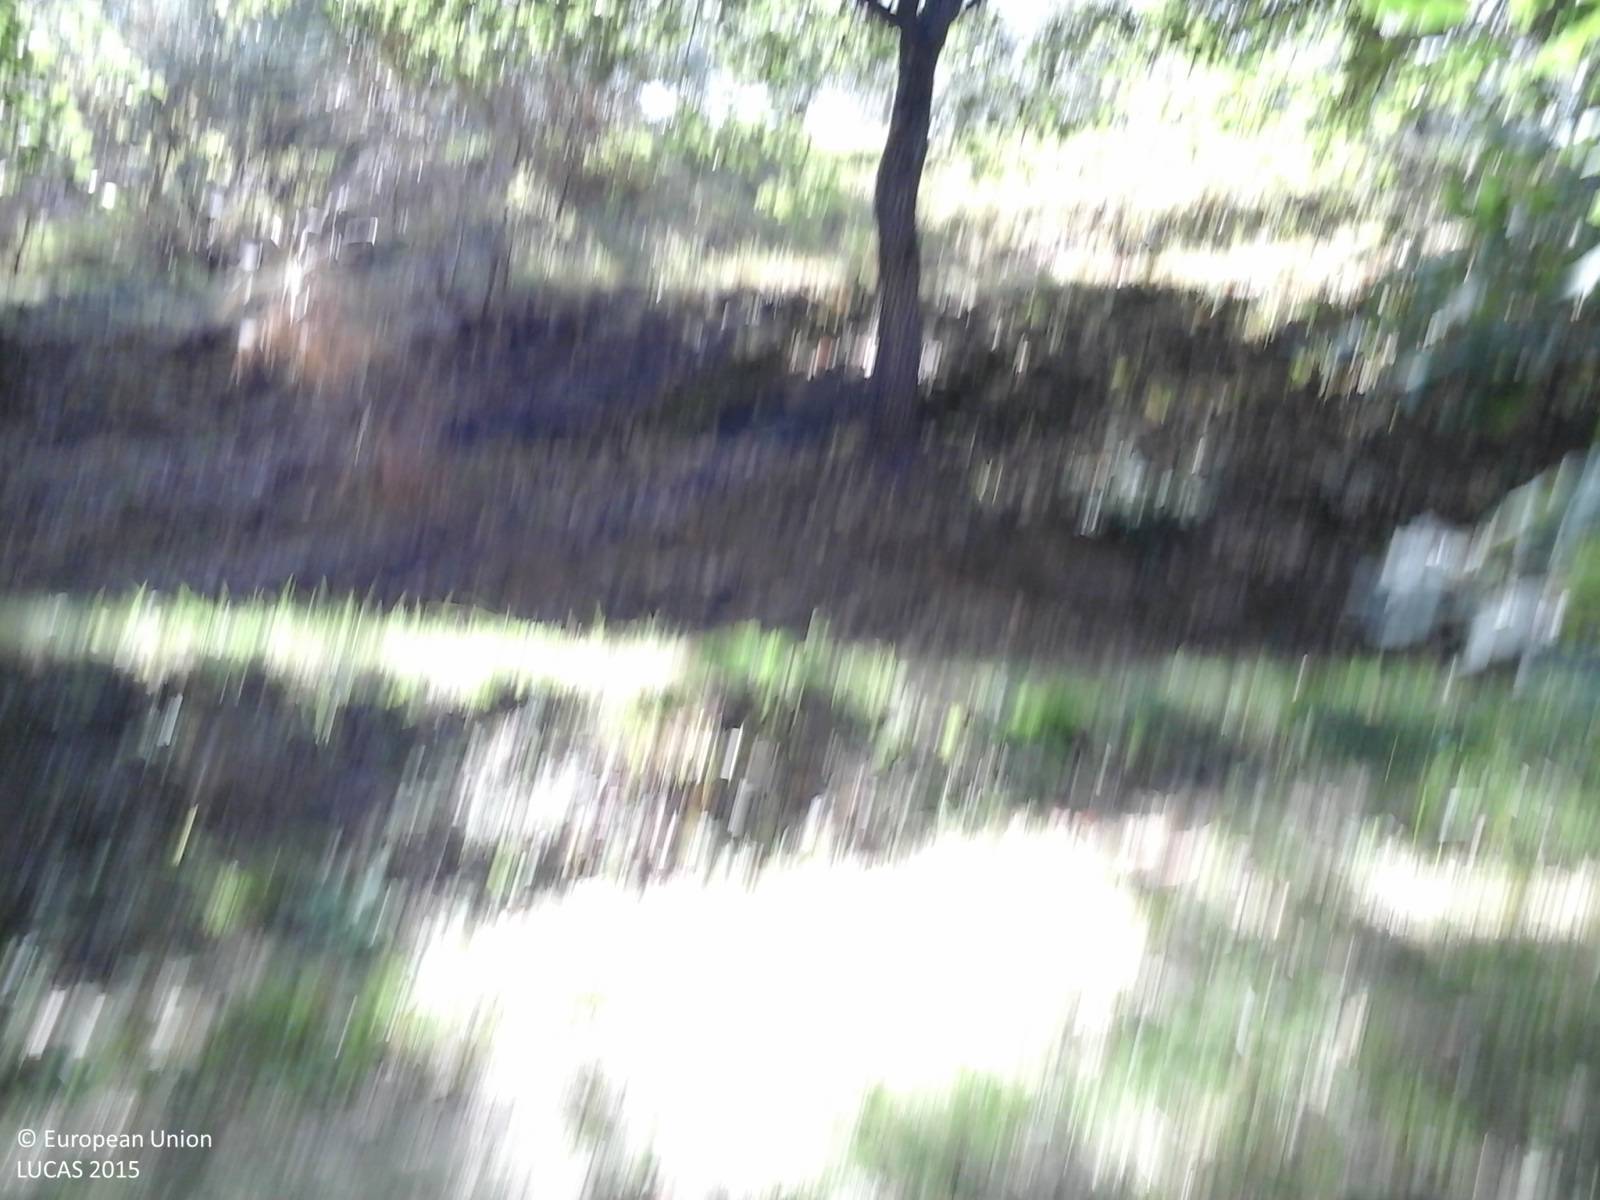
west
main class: Woodland
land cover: Broadleaved woodland
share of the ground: 50 - 75 %
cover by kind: broadleaved forest trees 70 %, shrubs 30 %
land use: Forestry
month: September
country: IT
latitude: 43.0298
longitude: 12.0924
